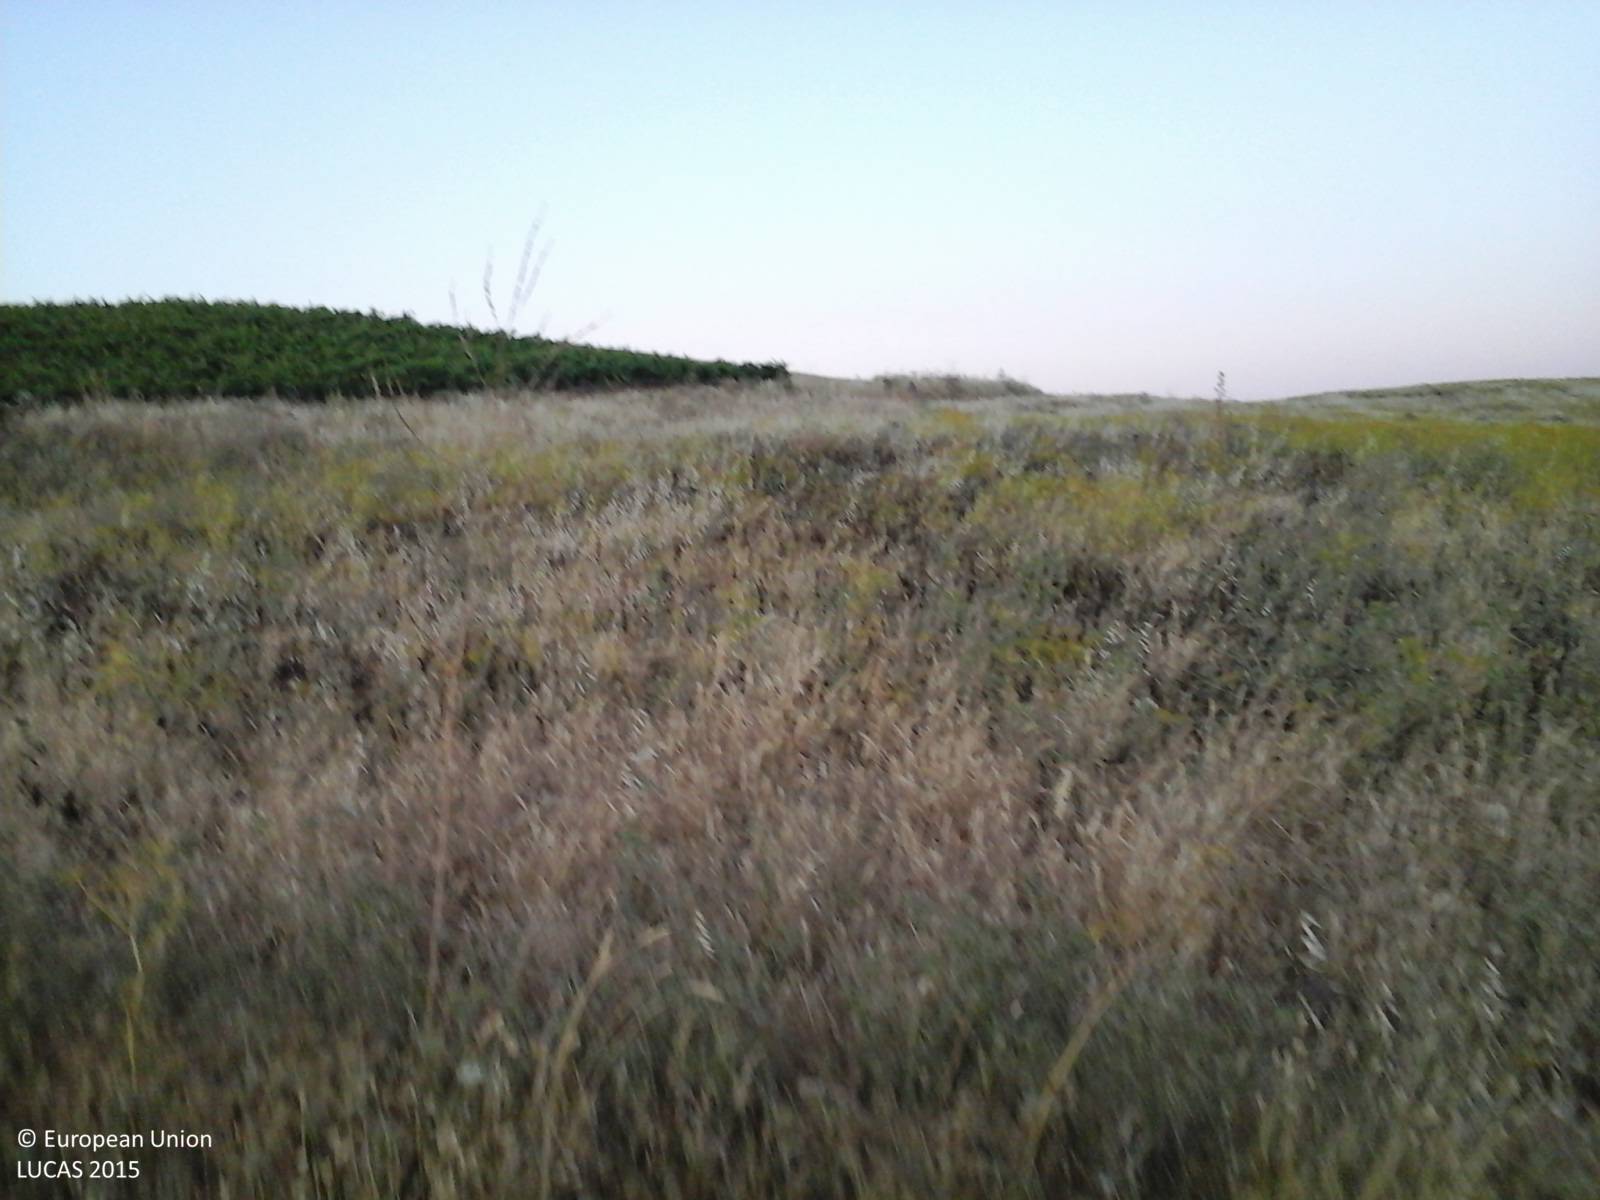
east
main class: Cropland
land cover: Durum wheat
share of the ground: > 75 %
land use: Agriculture (excluding fallow land and kitchen gardens)
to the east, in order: Durum wheat; Grass margins; Tracks; Grass margins; Other leguminous and mixtures for fodder; Grass margins; Paved roads, cycling and walking lanes; Grass margins; Other leguminous and mixtures for fodder
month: June
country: IT
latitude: 37.9434
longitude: 12.7677
